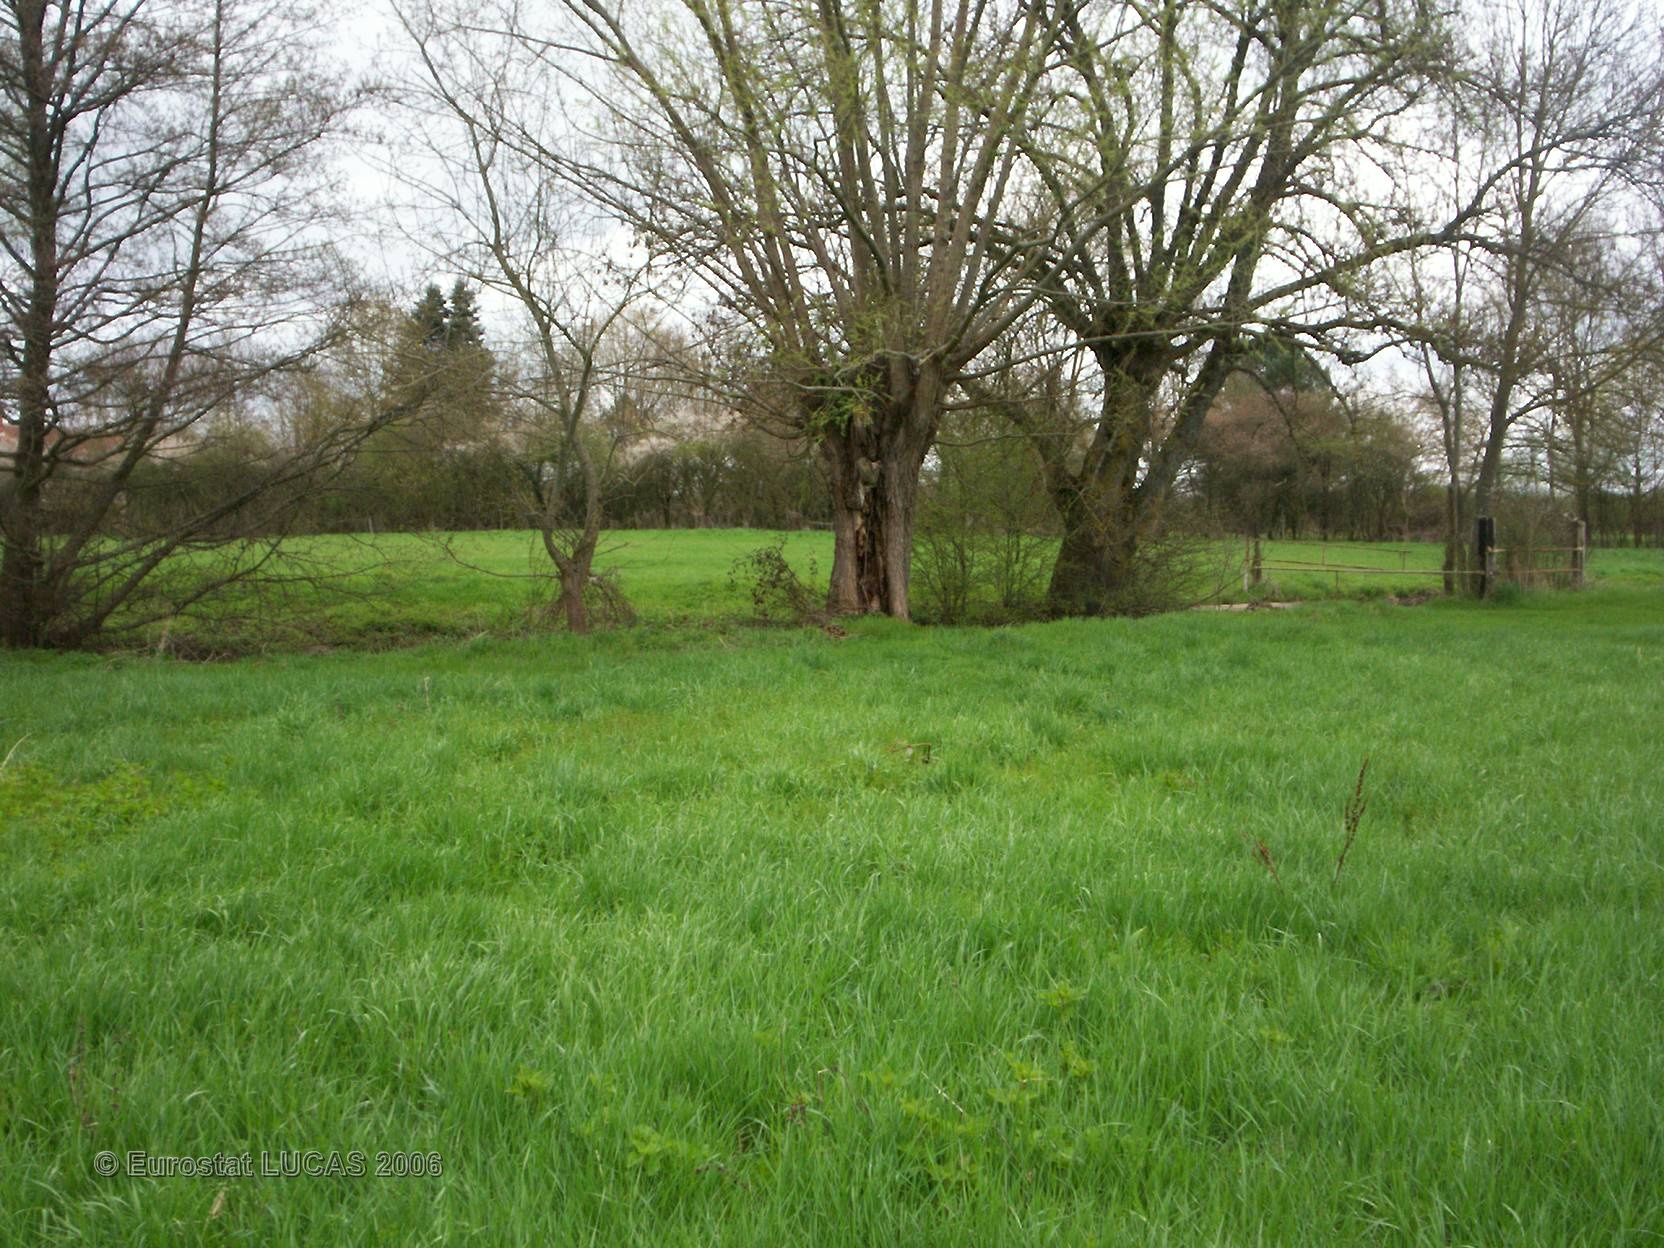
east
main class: Grassland
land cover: Grassland without tree/shrub cover
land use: Agriculture (excluding fallow land and kitchen gardens)
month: April
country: FR
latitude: 46.8502
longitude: 3.0850
